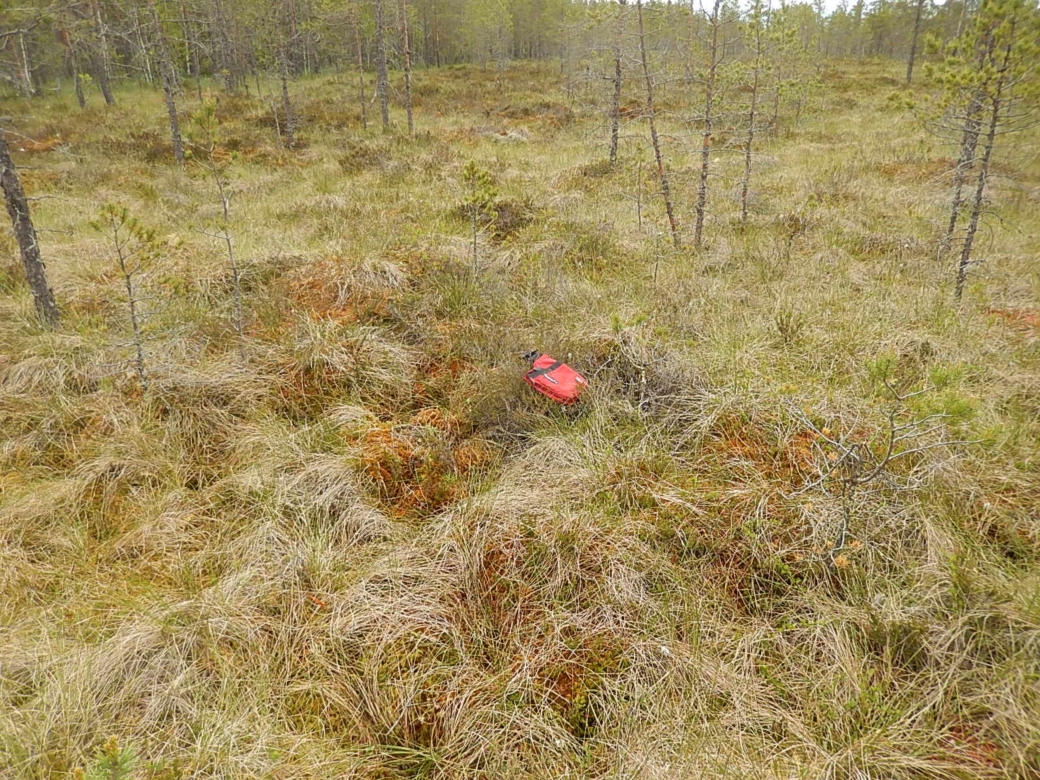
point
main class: Woodland
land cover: Pine dominated coniferous woodland
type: boreal forest
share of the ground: 50 - 75 %
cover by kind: coniferous forest trees 50 %, herbaceous plants 20 %, lichens and mosses 20 %, shrubs 10 %
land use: Forestry
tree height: > 5 m
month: June
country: FI
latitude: 61.9321
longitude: 22.1917
